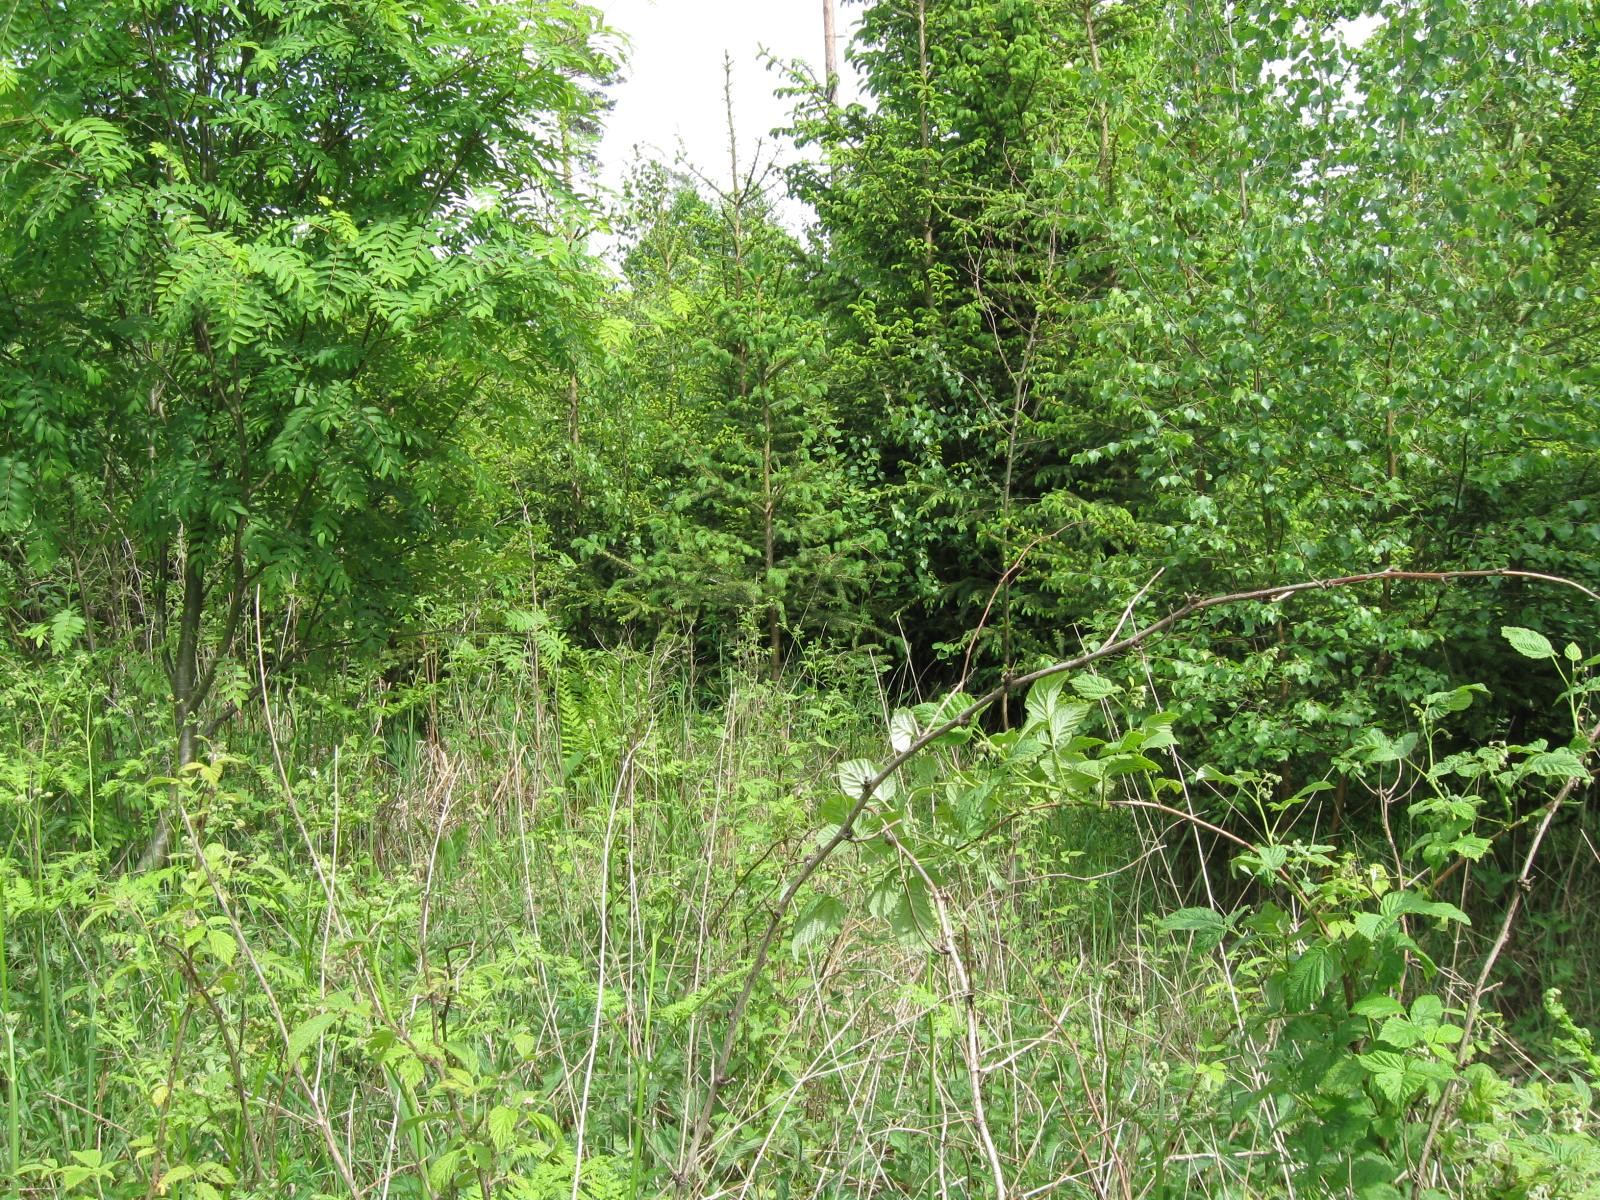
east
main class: Woodland
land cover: Spruce dominated mixed woodland
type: hemiboreal forest and nemoral coniferous forest and mixed broadleaved-coniferous forest
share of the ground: > 75 %
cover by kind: coniferous forest trees 30 %, broadleaved forest trees 30 %, herbaceous plants 30 %, shrubs 10 %
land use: Forestry
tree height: < 5 m
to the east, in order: Spruce dominated mixed woodland; Tracks; Spruce dominated mixed woodland; Electric lines; Spruce dominated mixed woodland
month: June
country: LT
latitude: 54.6410
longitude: 23.8954
